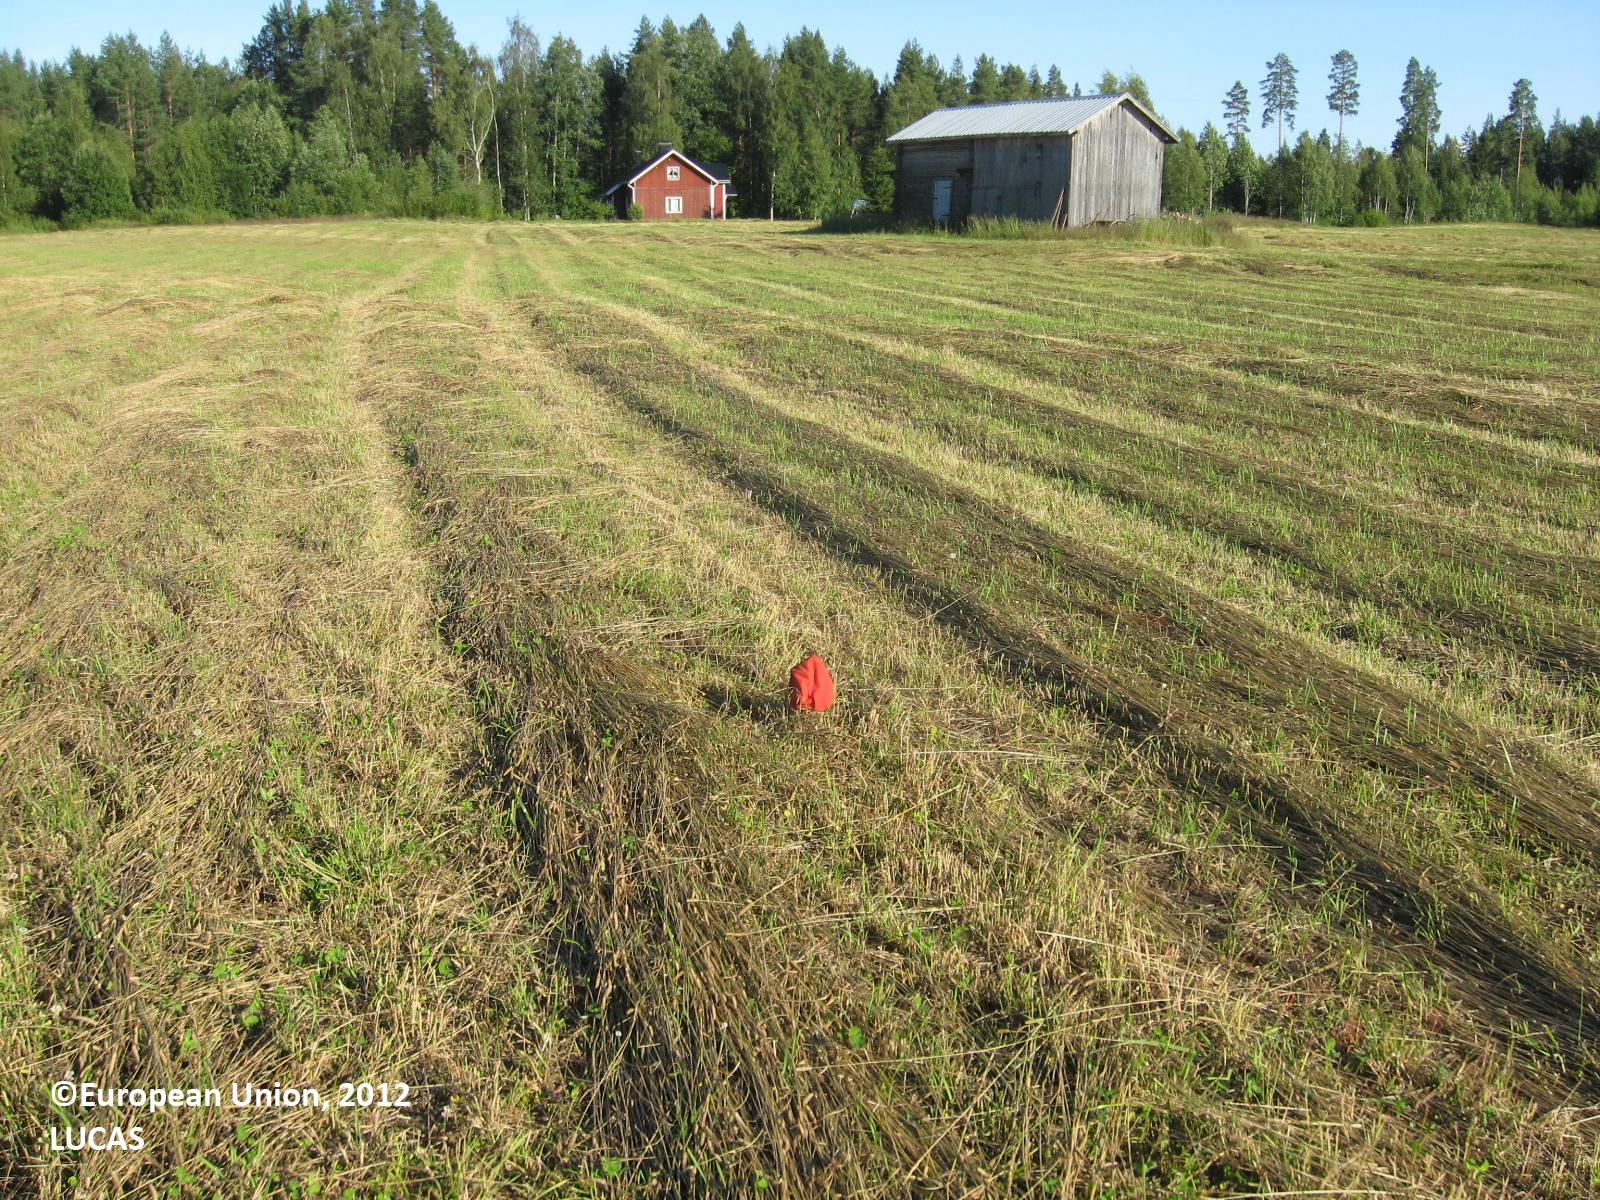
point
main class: Cropland
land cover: Temporary grasslands
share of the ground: > 75 %
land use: Agriculture (excluding fallow land and kitchen gardens)
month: July
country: FI
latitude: 62.1110
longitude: 22.4570
